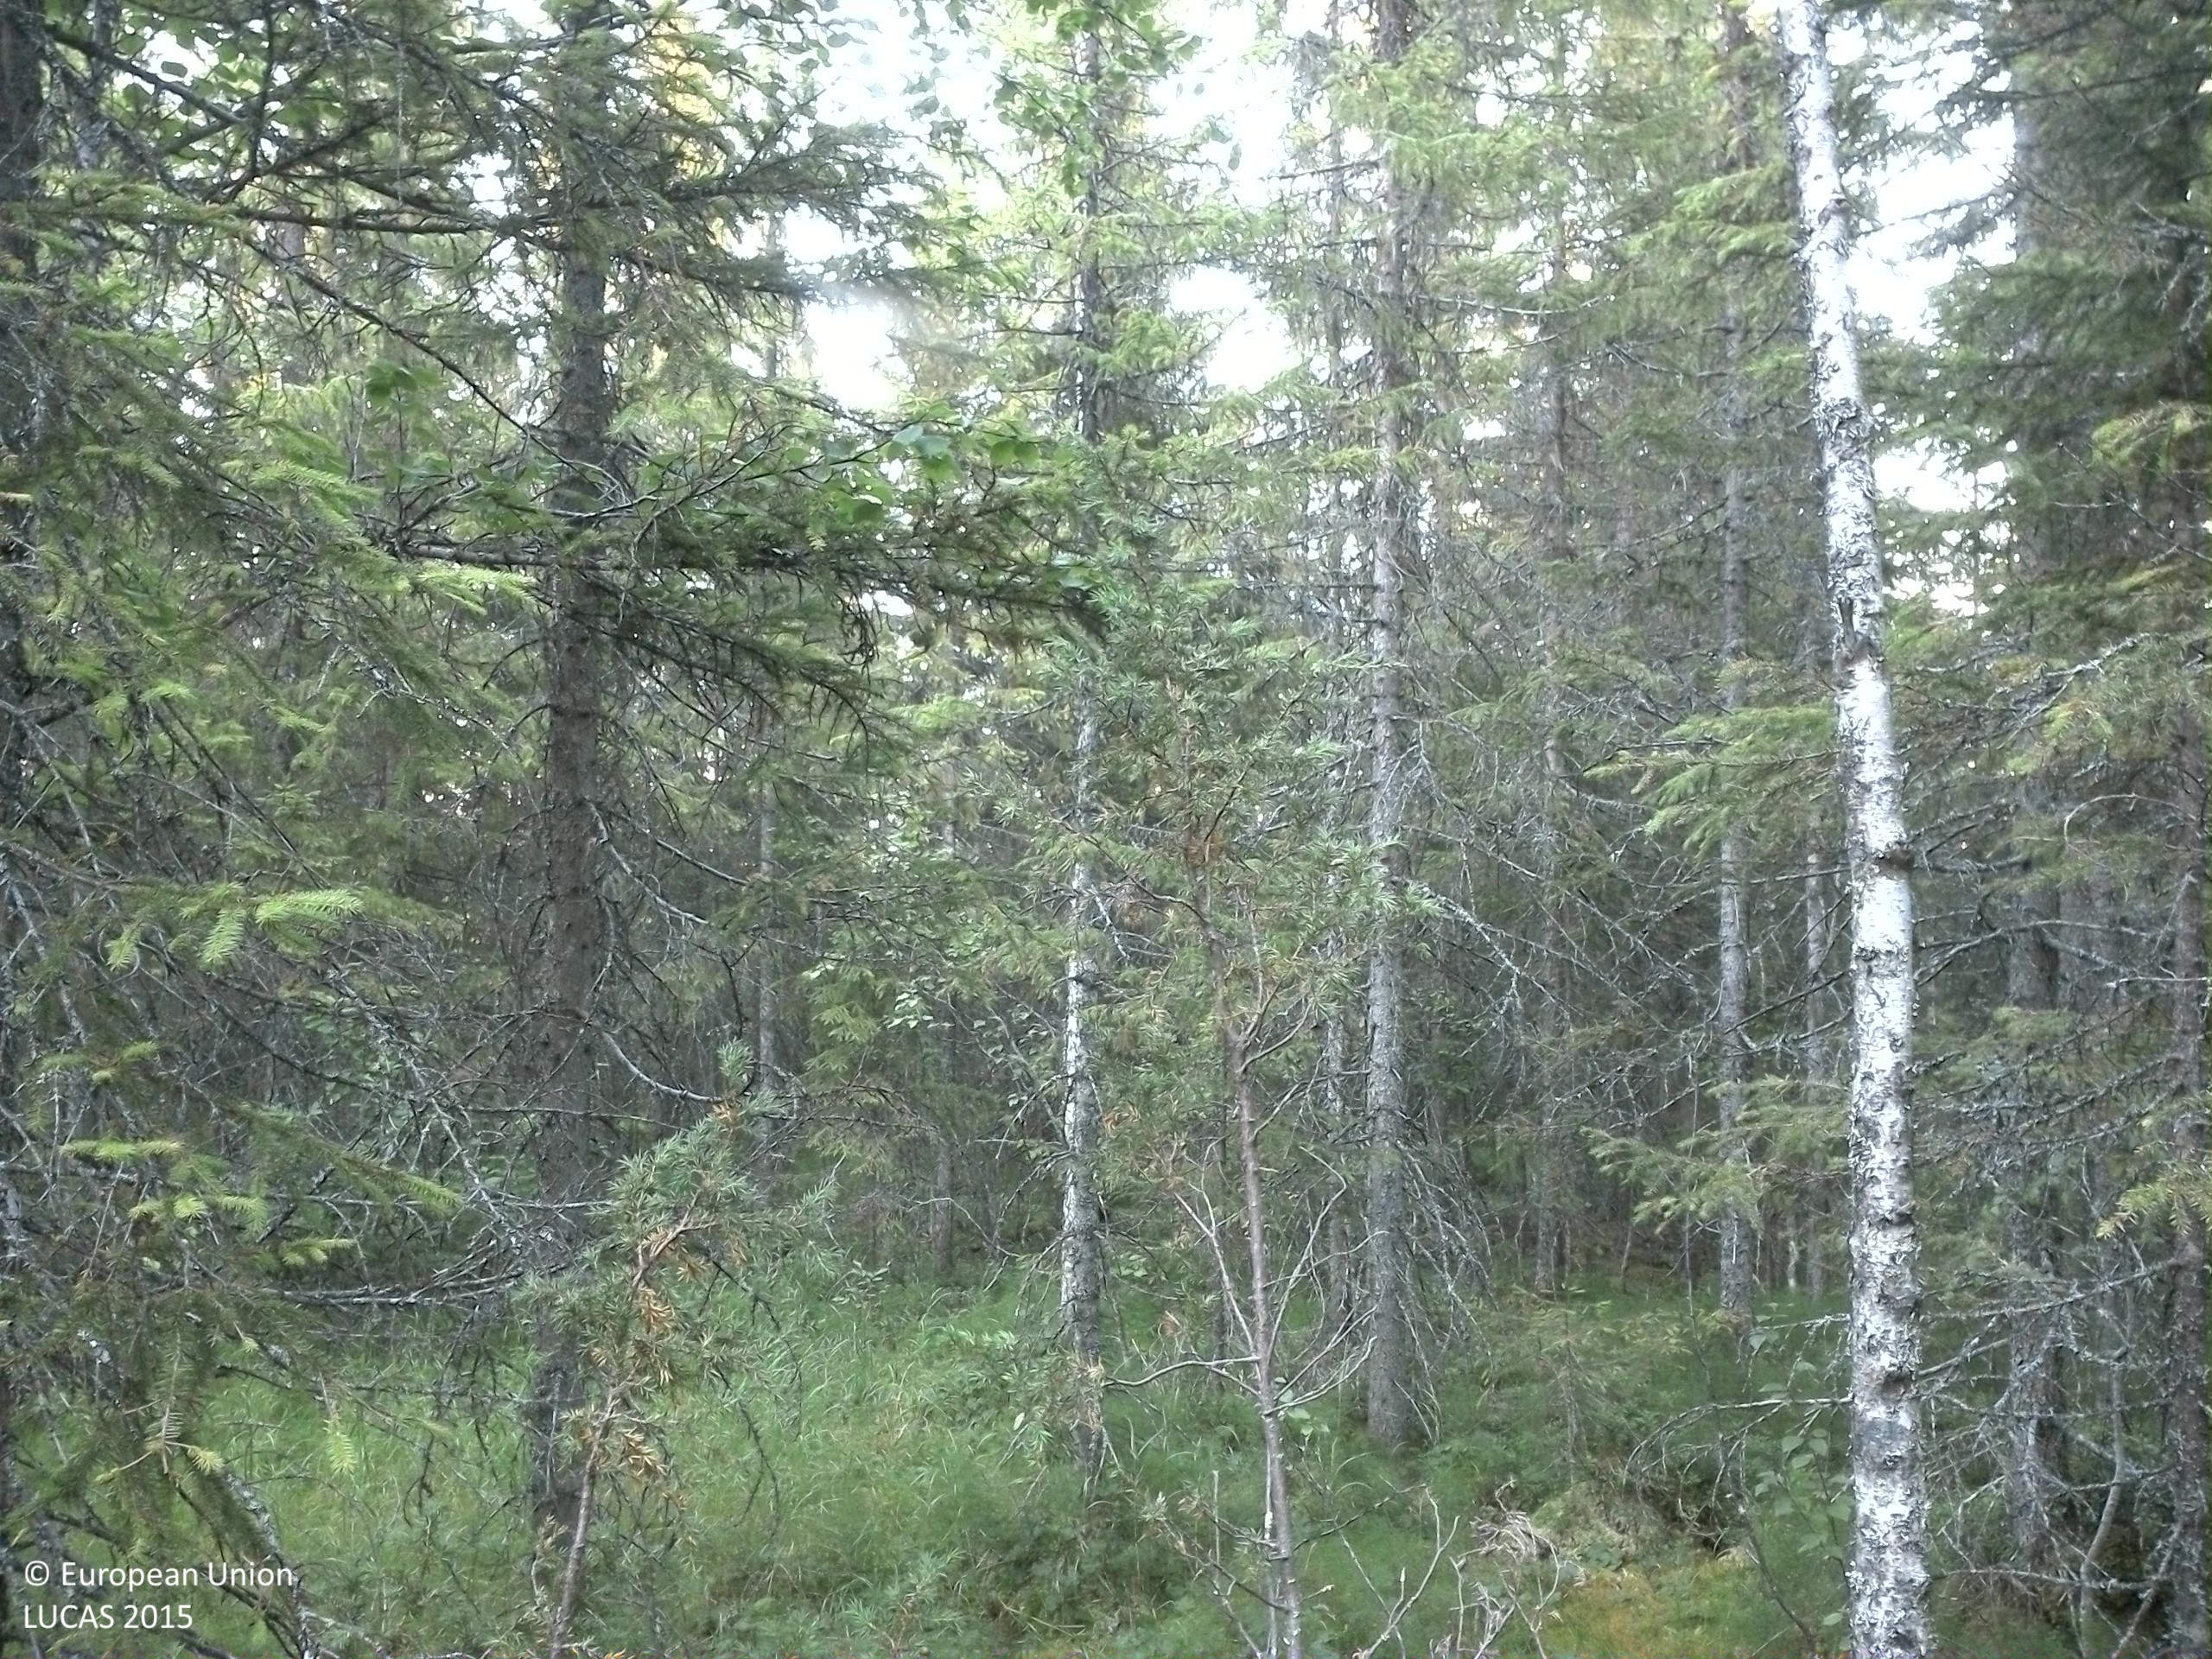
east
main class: Woodland
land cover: Spruce dominated mixed woodland
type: boreal forest
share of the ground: > 75 %
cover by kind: coniferous forest trees 45 %, shrubs 25 %, broadleaved forest trees 20 %, herbaceous plants 10 %
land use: Forestry
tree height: > 5 m
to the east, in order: Spruce dominated mixed woodland; Ditches and canals; Spruce dominated mixed woodland; Spruce dominated coniferous woodland; Ditches and canals; Spruce dominated mixed woodland; Ditches and canals; Spruce dominated mixed woodland; Pine dominated coniferous woodland
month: August
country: SE
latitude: 63.8212
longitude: 17.8753
